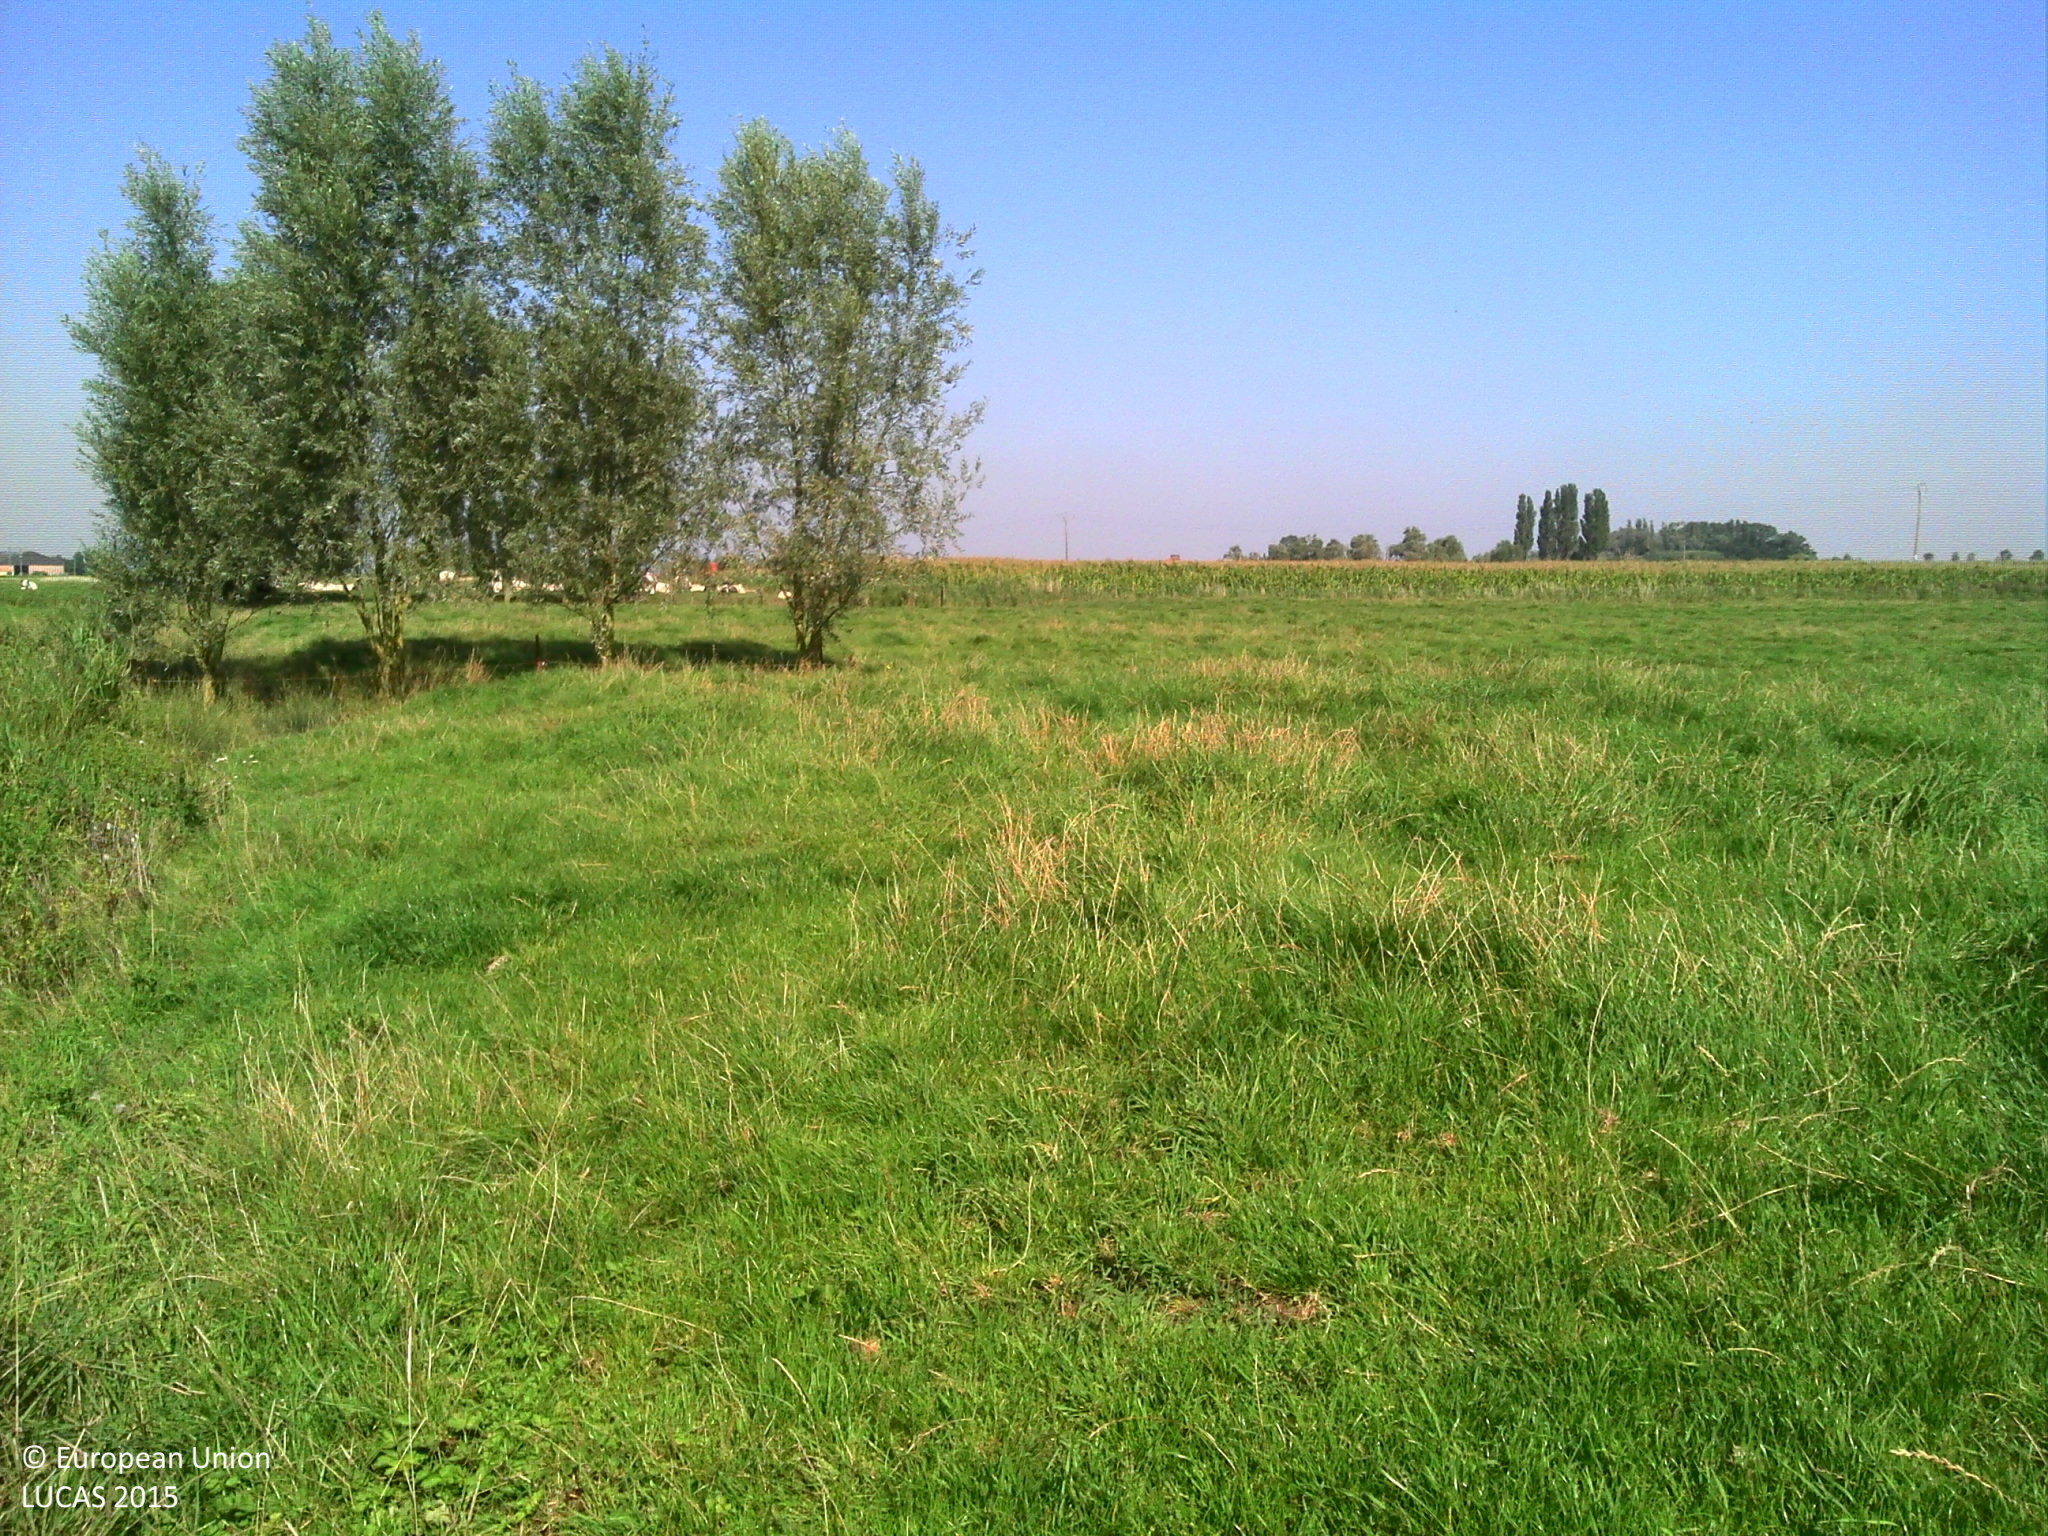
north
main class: Grassland
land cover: Grassland without tree/shrub cover
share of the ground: > 75 %
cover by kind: herbaceous plants 100 %
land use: Agriculture (excluding fallow land and kitchen gardens)
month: September
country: BE
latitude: 51.0031
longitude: 2.7922
